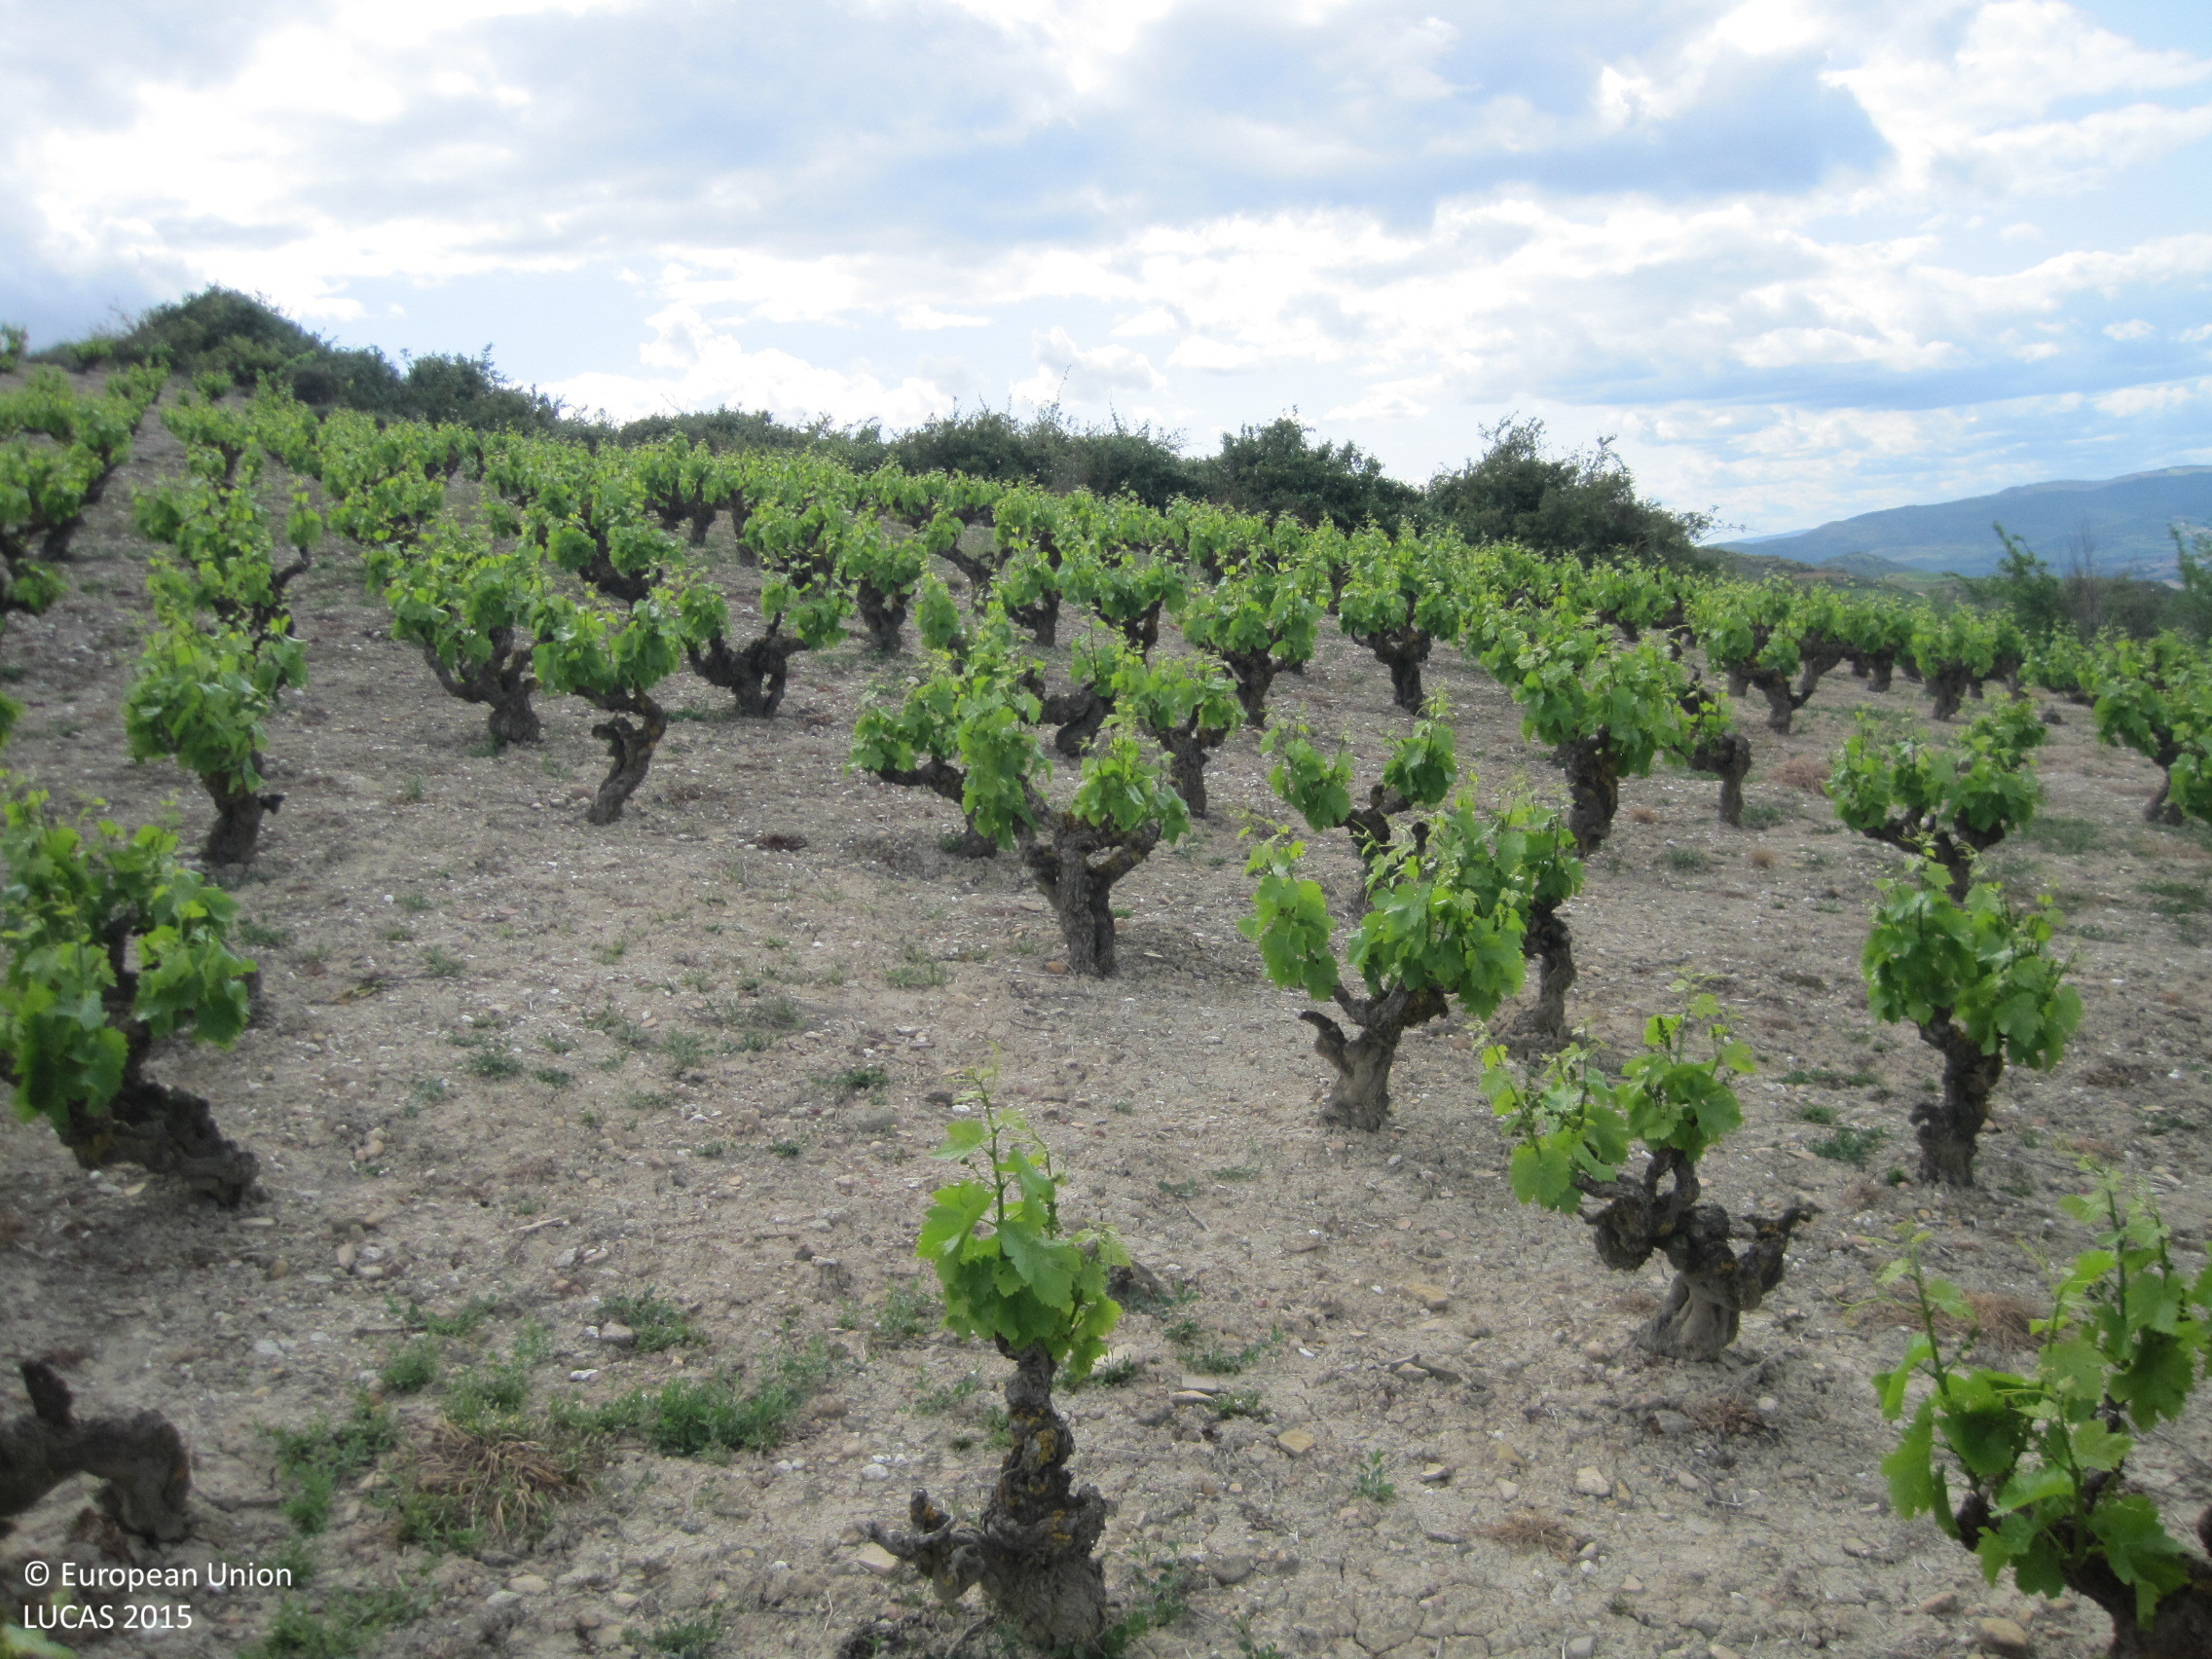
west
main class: Cropland
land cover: Vineyards
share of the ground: 10 - 25 %
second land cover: Other bare soil
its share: > 75 %
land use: Agriculture (excluding fallow land and kitchen gardens)
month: May
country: ES
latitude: 42.6645
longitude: -1.7144
